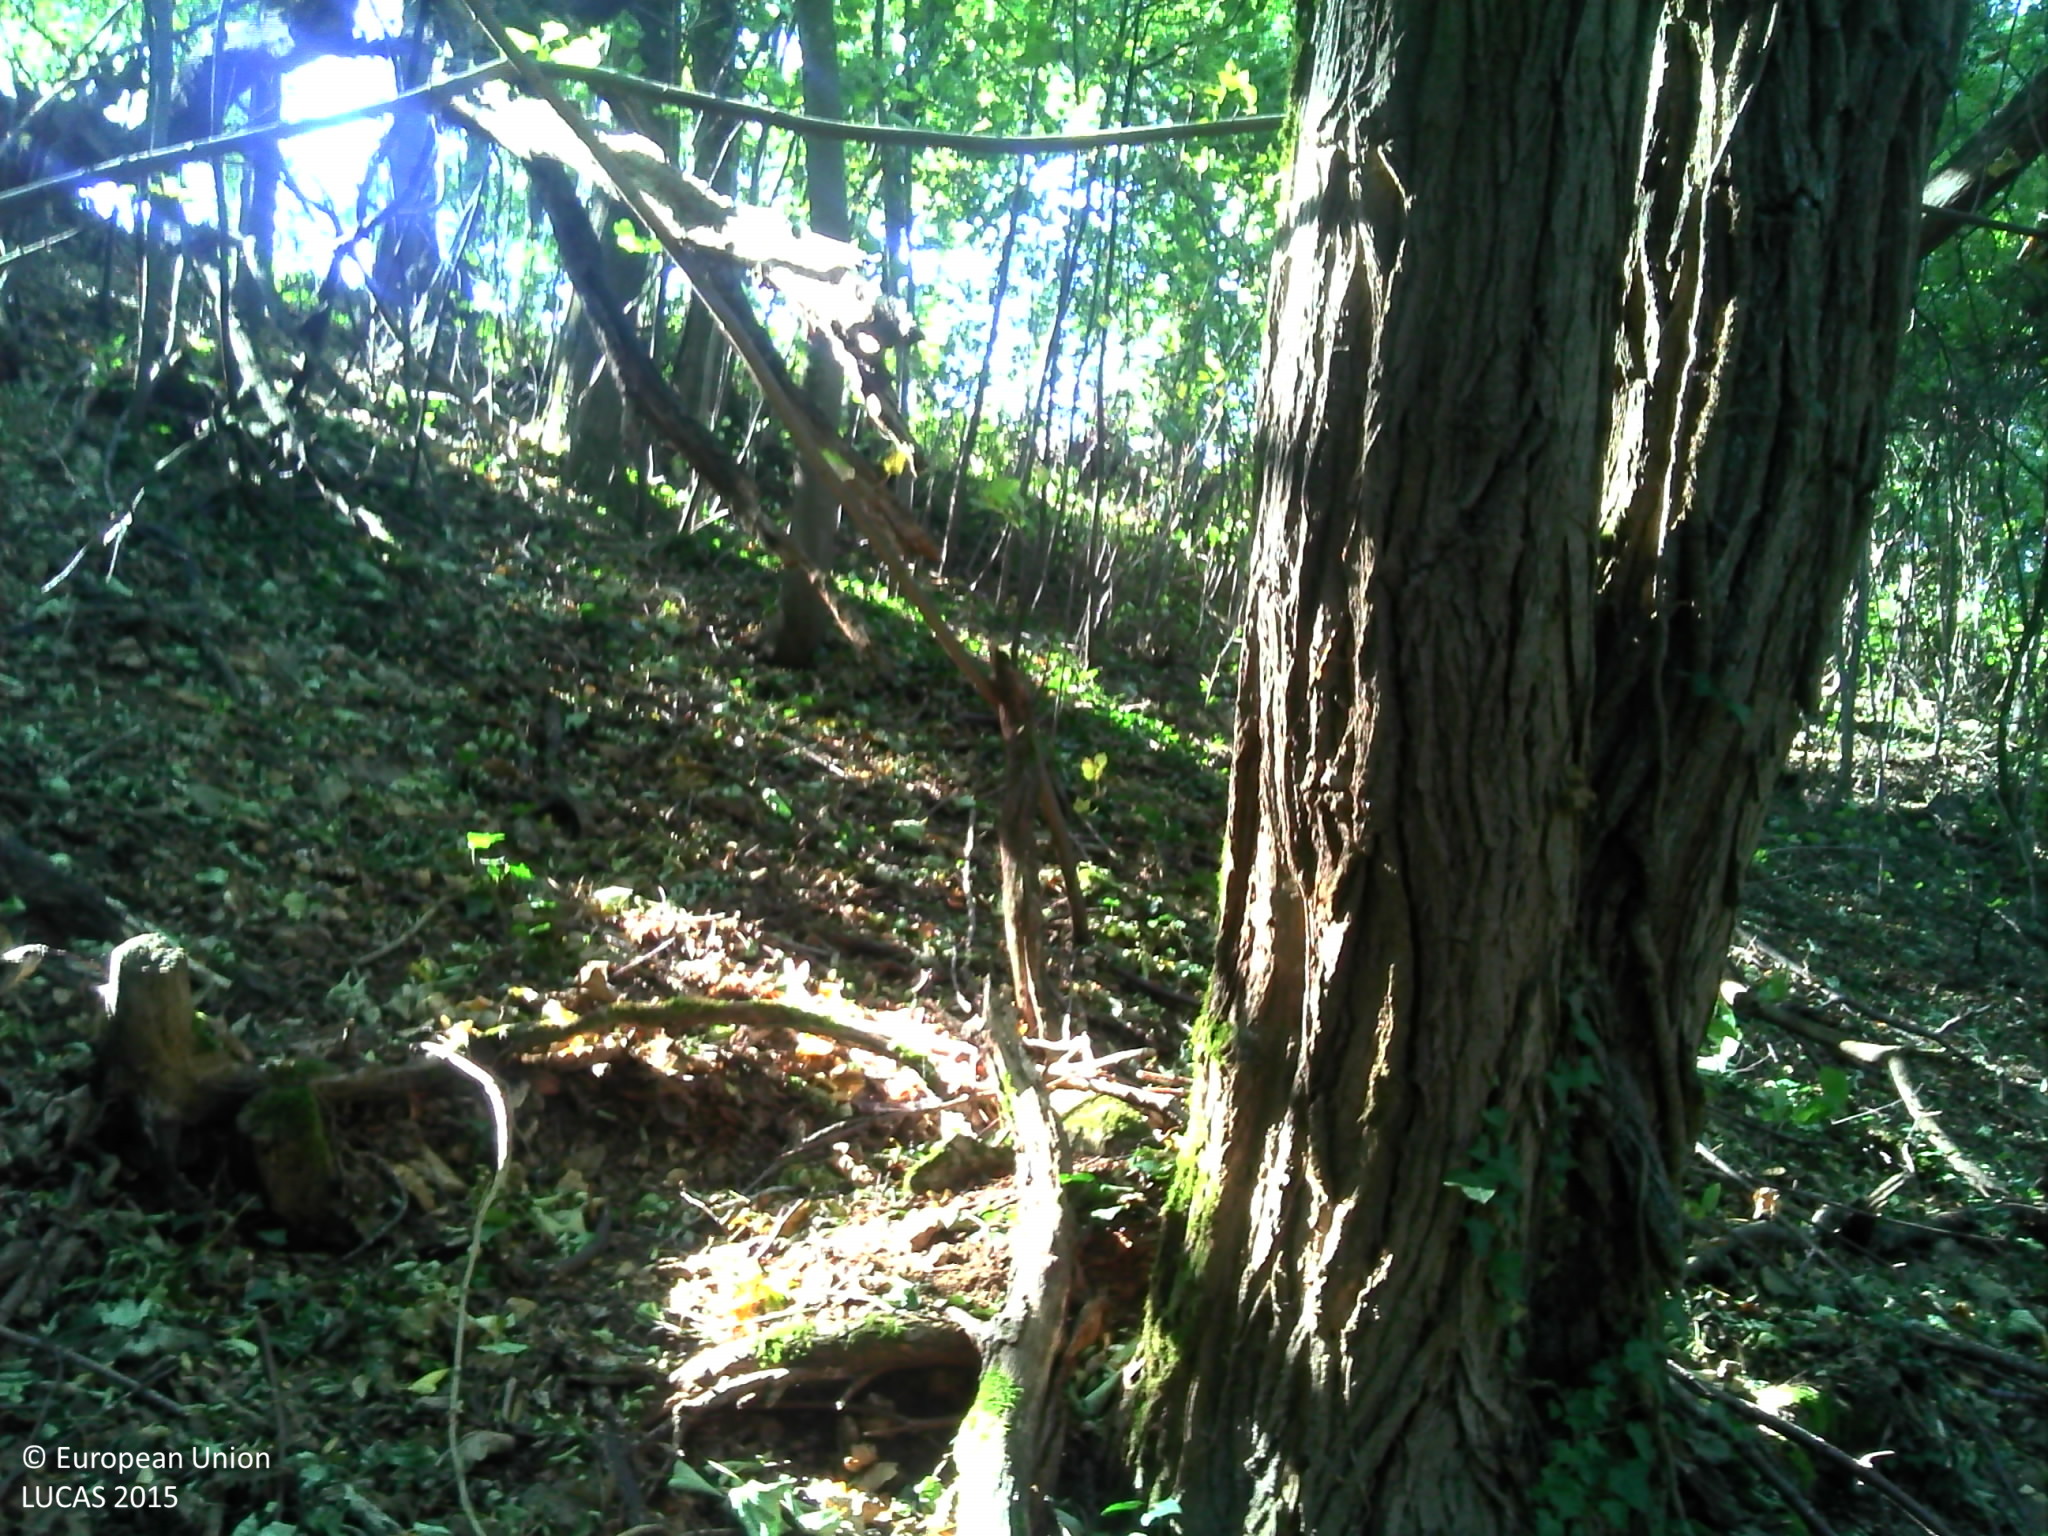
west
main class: Woodland
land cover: Broadleaved woodland
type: mesophytic deciduous forest
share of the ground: > 75 %
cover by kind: broadleaved forest trees 90 %, herbaceous plants 5 %, consolidated bare surface 5 %
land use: Forestry
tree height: > 5 m
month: October
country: FR
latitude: 48.9086
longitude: 6.0293
